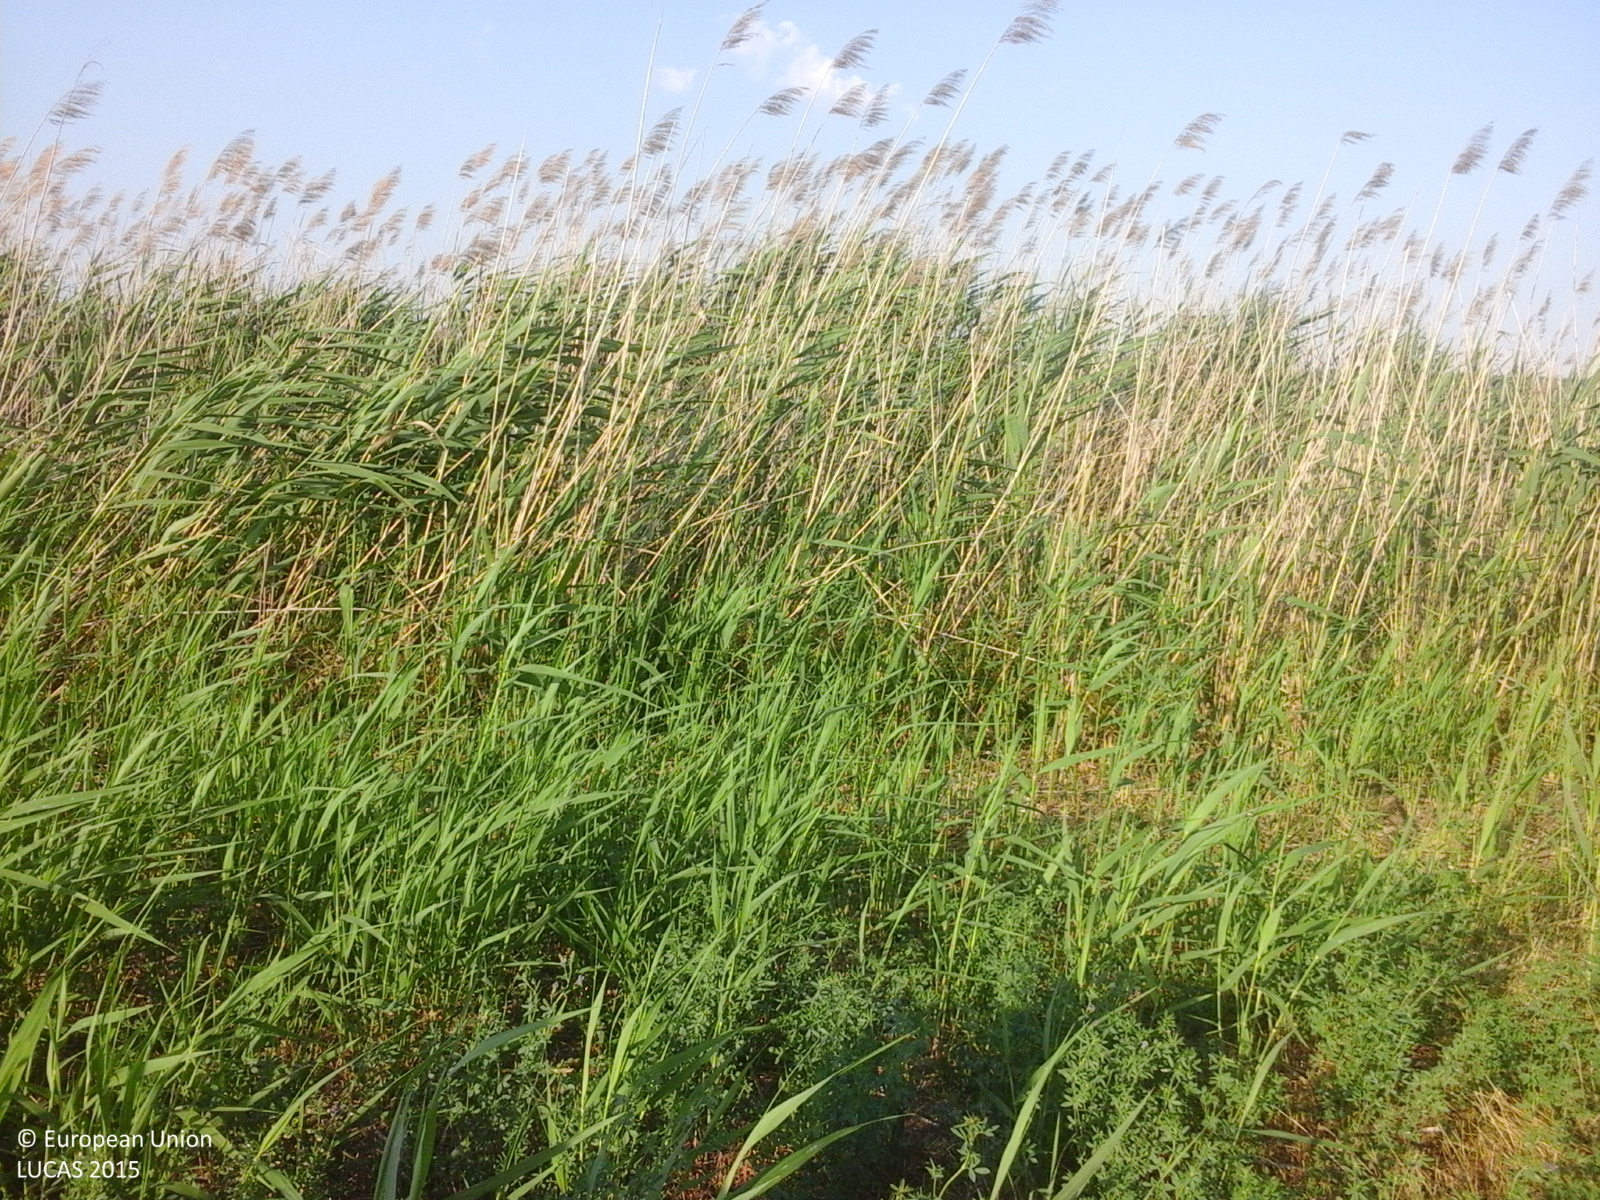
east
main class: Cropland
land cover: Lucerne
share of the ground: > 75 %
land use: Agriculture (excluding fallow land and kitchen gardens)
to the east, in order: Lucerne; Inland marshes; Ditches and canals; Grass margins; Tracks; Grass margins; Lucerne; Grassland without tree/shrub cover
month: June
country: RO
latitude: 46.6223
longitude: 27.7363
